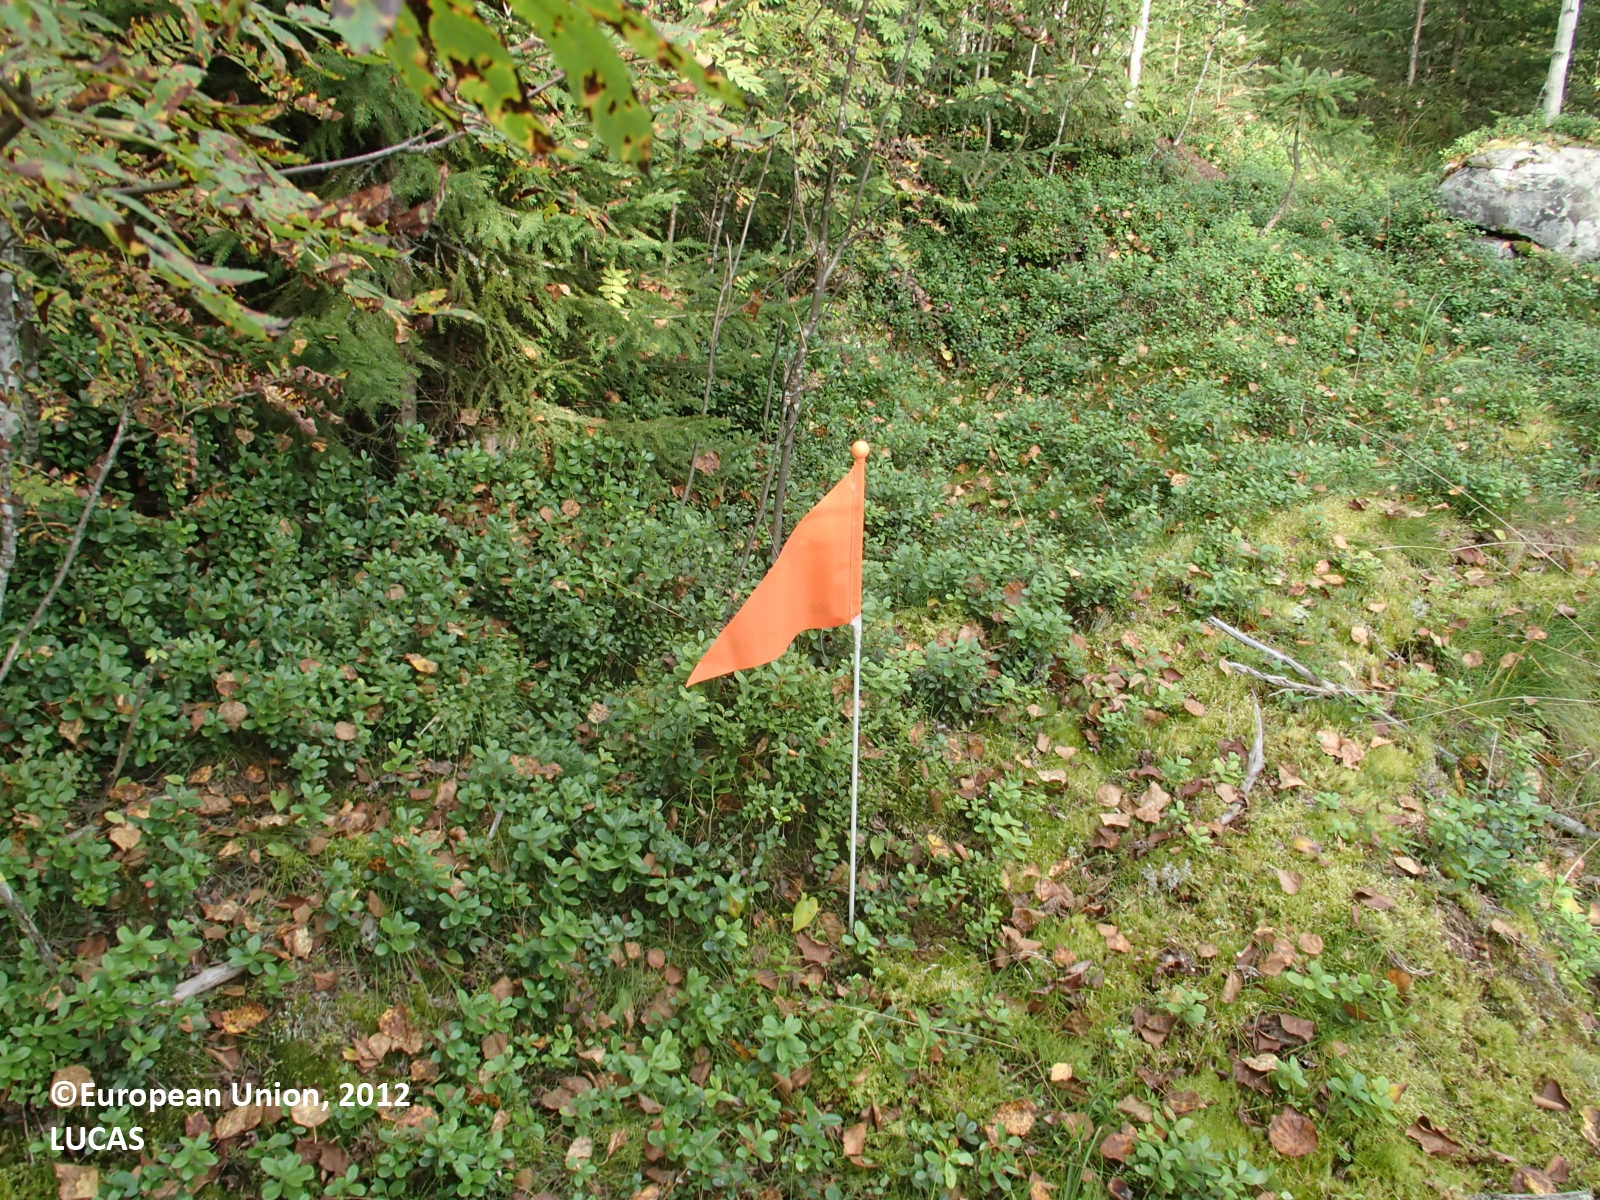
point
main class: Woodland
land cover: Spruce dominated mixed woodland
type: boreal forest
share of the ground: > 75 %
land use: Forestry
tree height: > 5 m
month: August
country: FI
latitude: 63.7380
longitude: 27.0953
